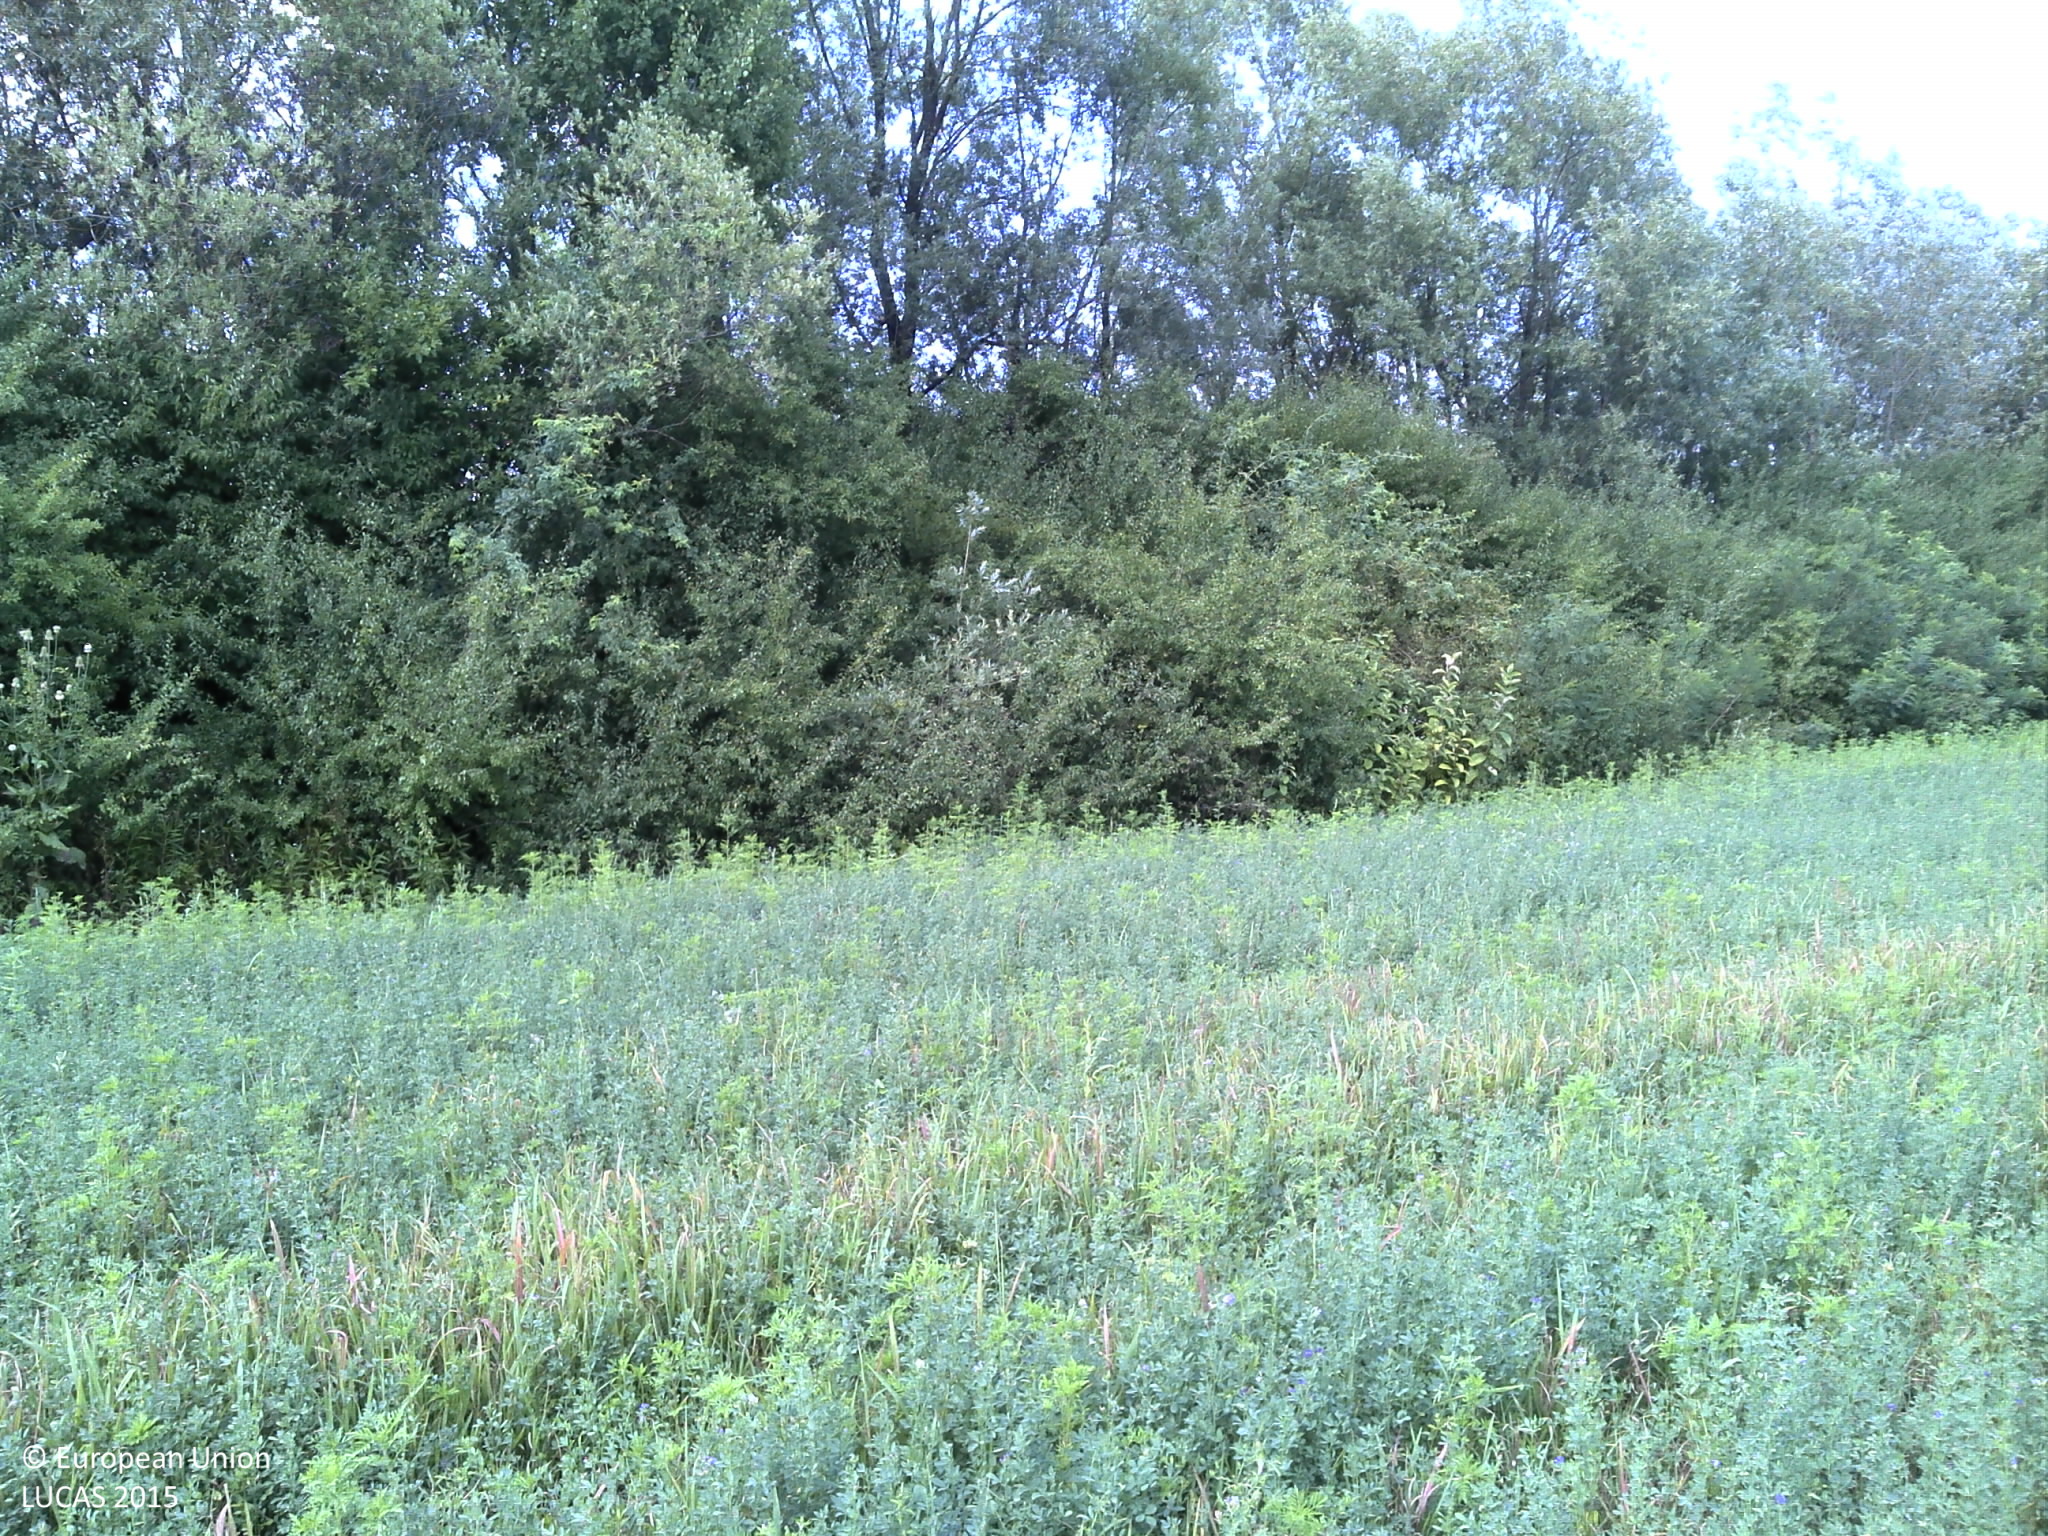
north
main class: Cropland
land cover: Clovers
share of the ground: > 75 %
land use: Agriculture (excluding fallow land and kitchen gardens)
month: August
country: HR
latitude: 45.4857
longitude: 16.4849
